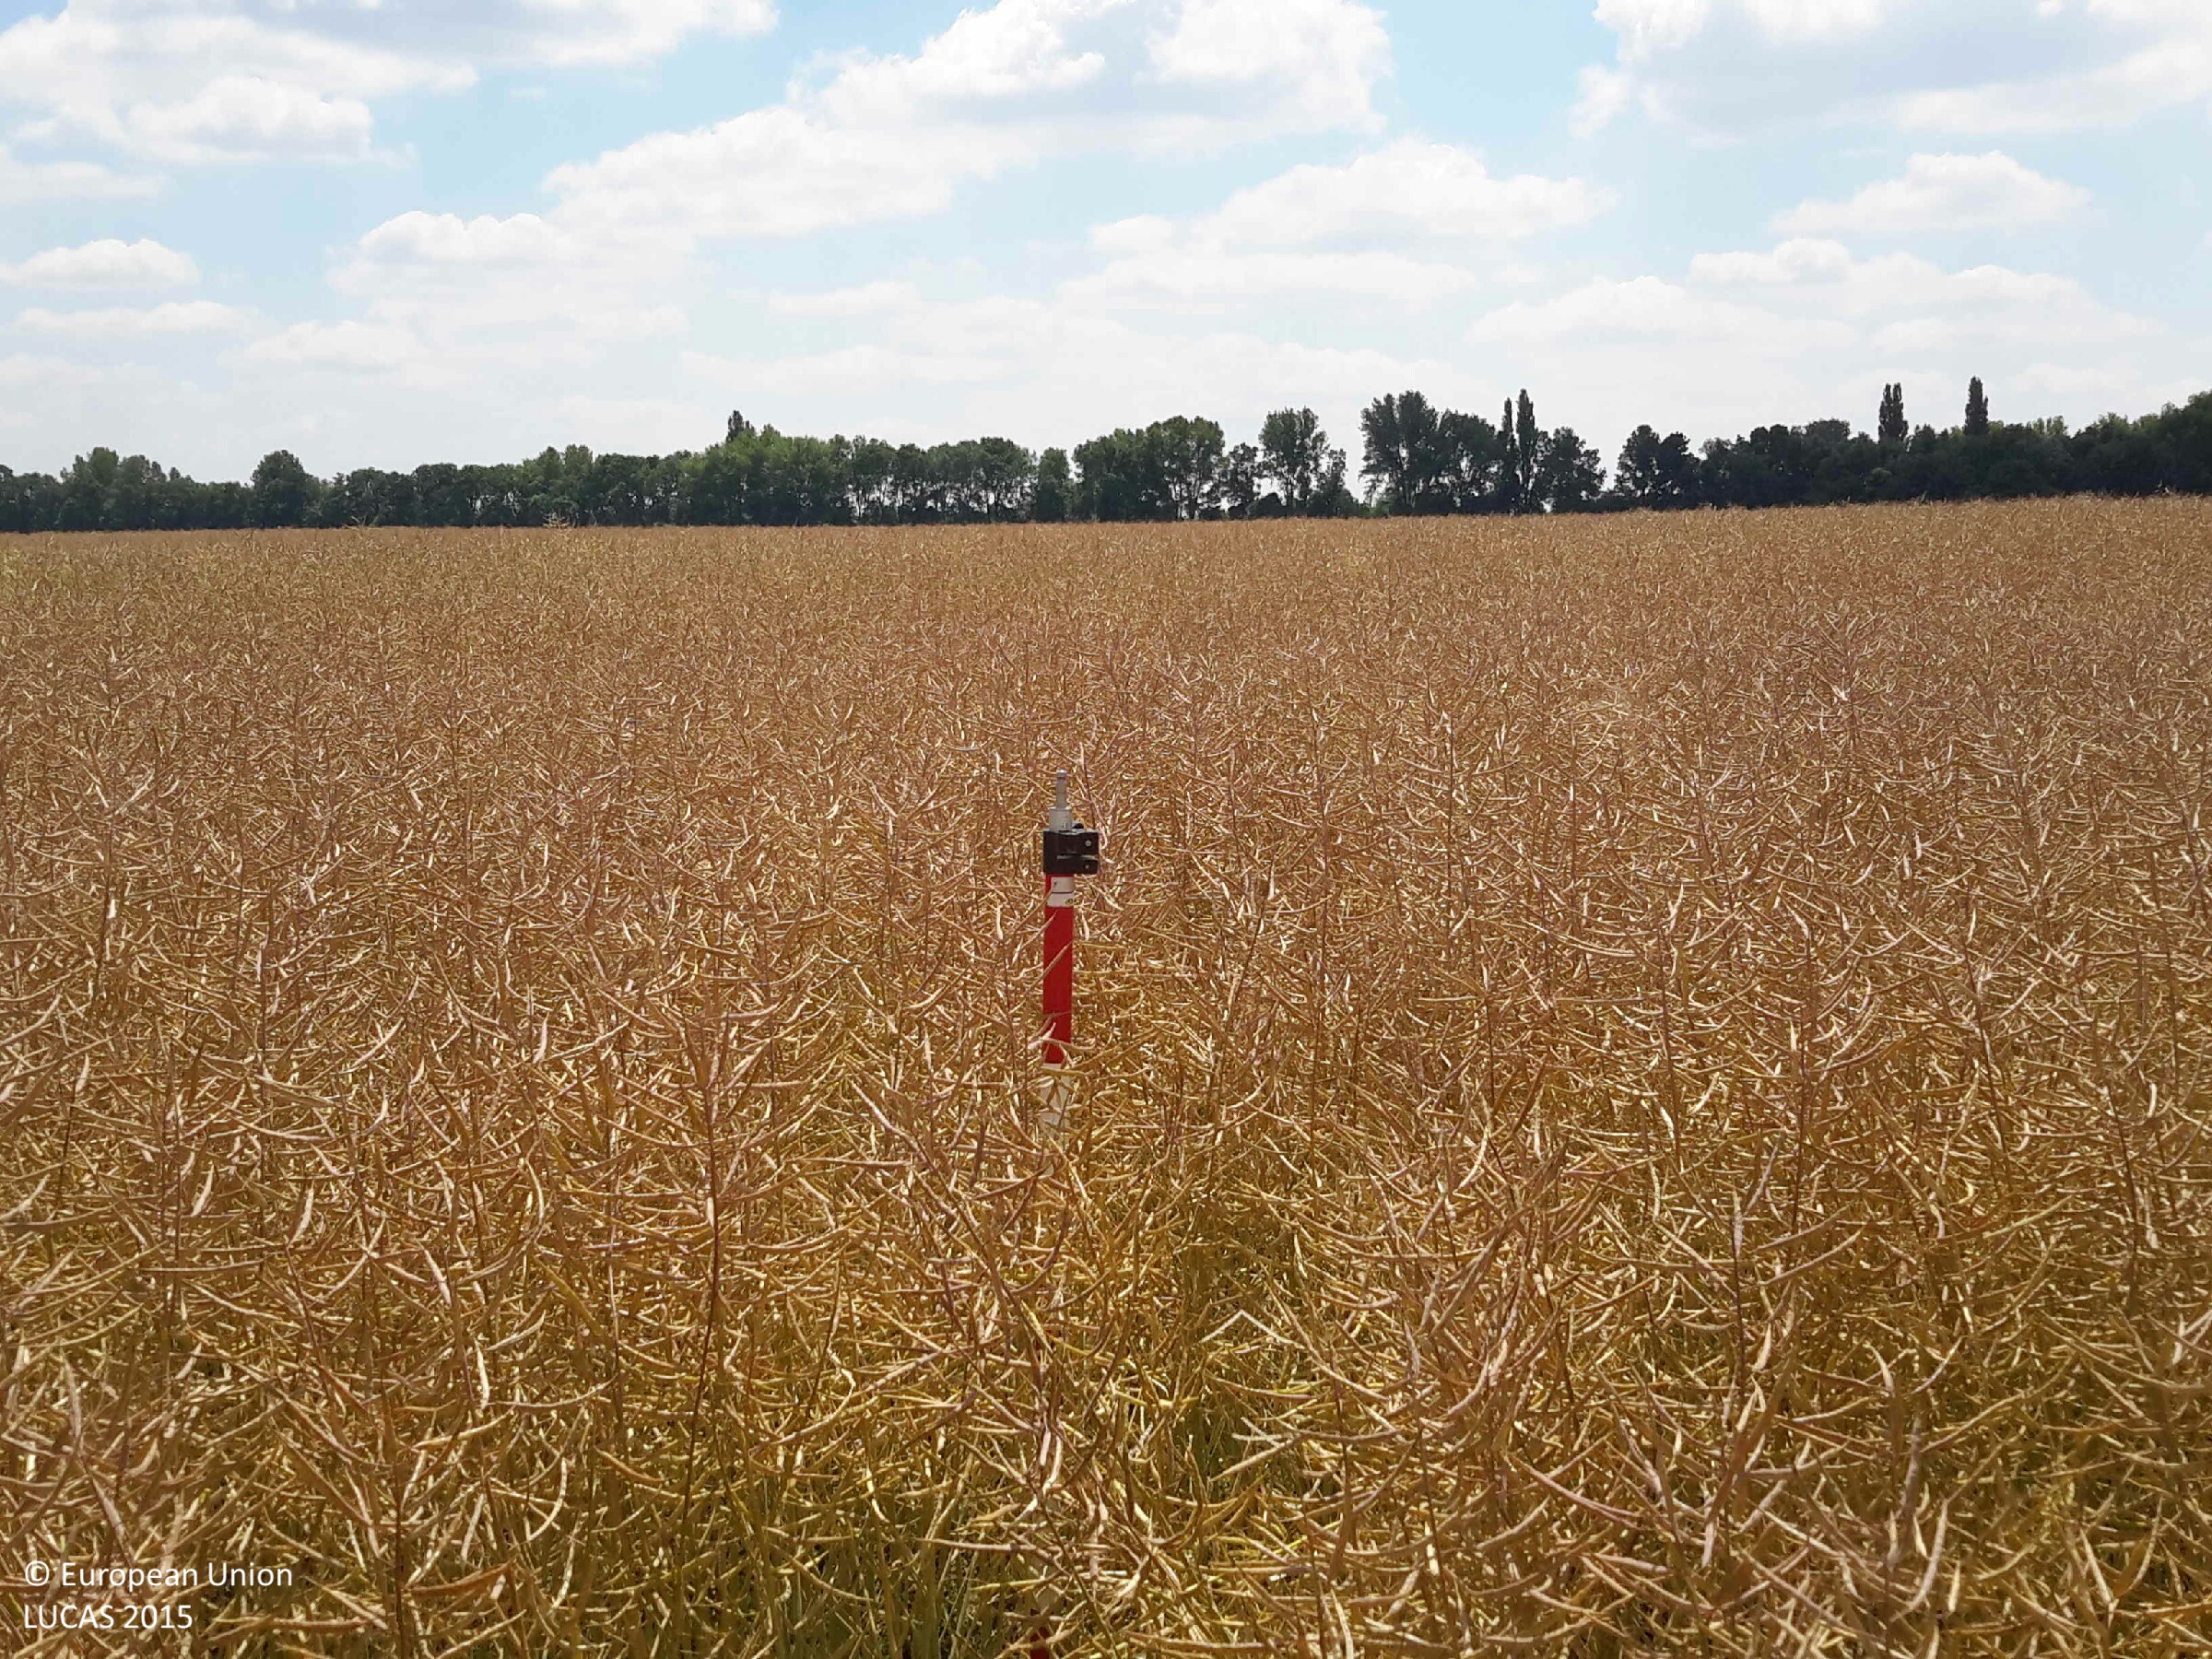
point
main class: Cropland
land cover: Rape and turnip rape
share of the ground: > 75 %
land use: Agriculture (excluding fallow land and kitchen gardens)
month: June
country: HU
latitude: 47.7534
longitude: 17.4653
